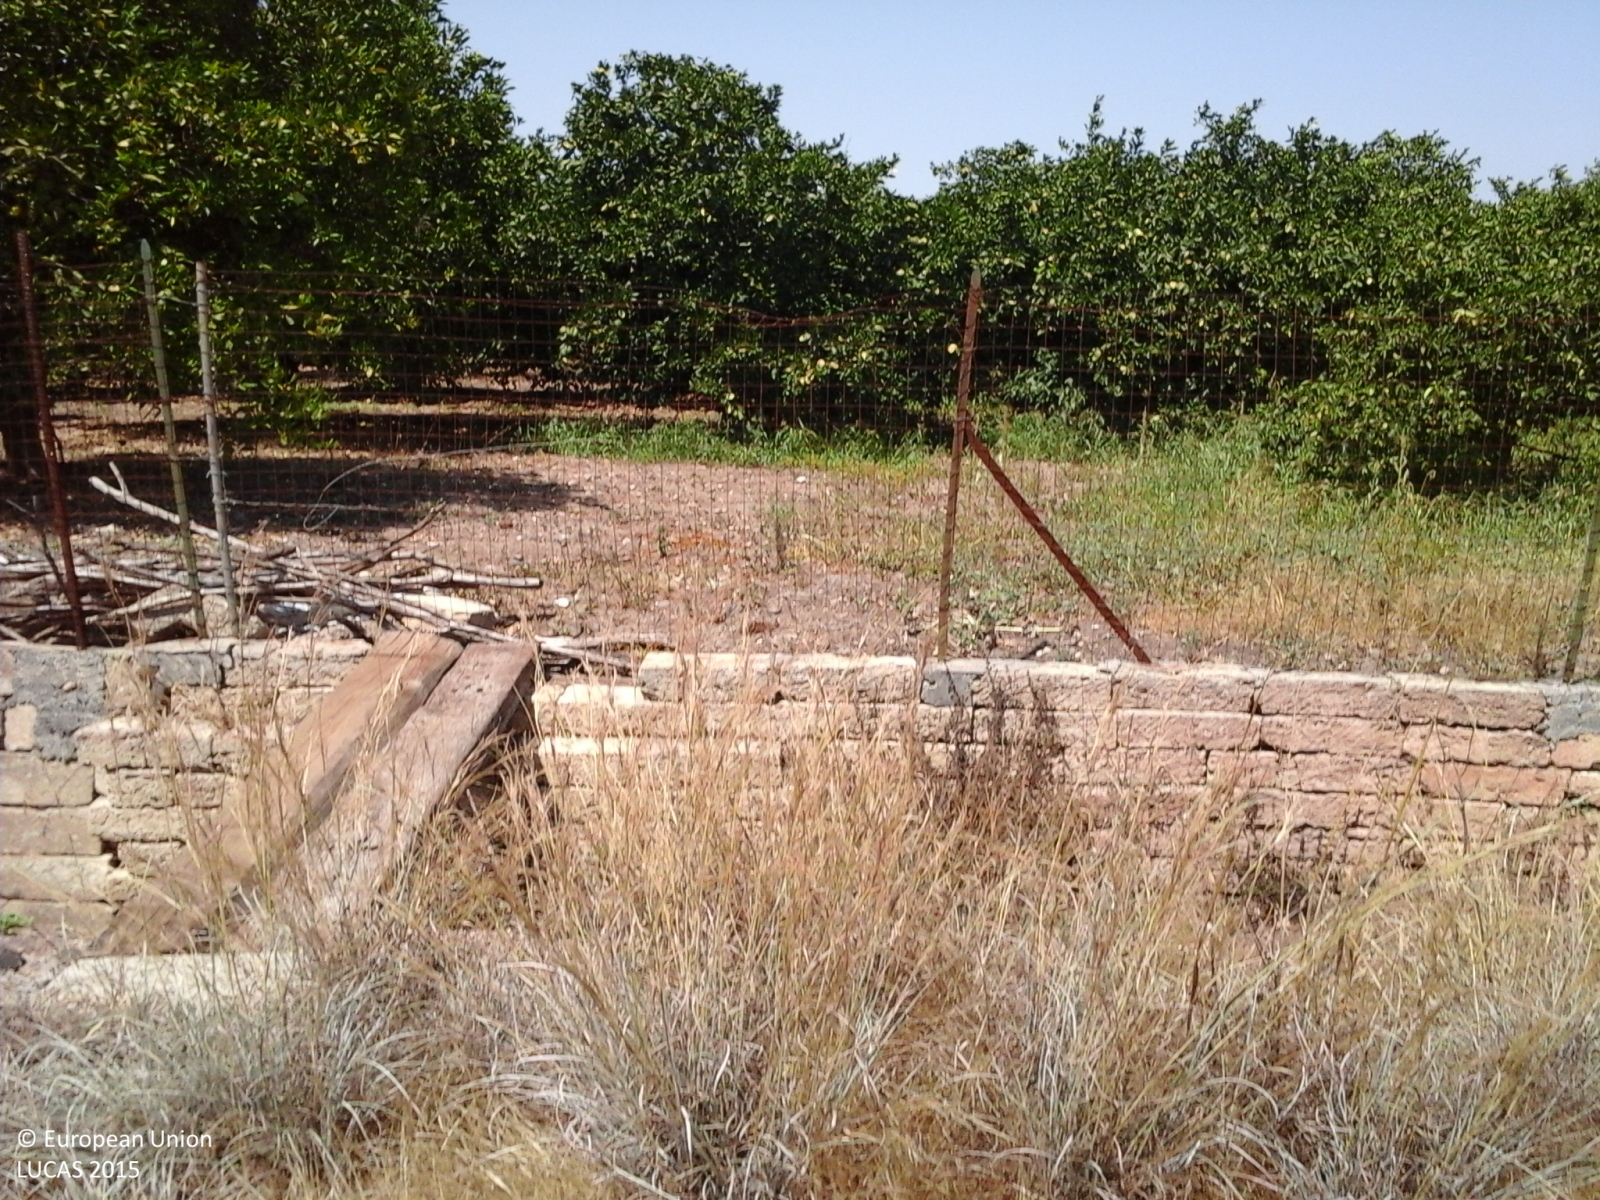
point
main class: Cropland
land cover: Oranges
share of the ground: > 75 %
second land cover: Spontaneously vegetated surfaces
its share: > 75 %
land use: Agriculture (excluding fallow land and kitchen gardens)
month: August
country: IT
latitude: 37.3123
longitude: 14.8944
